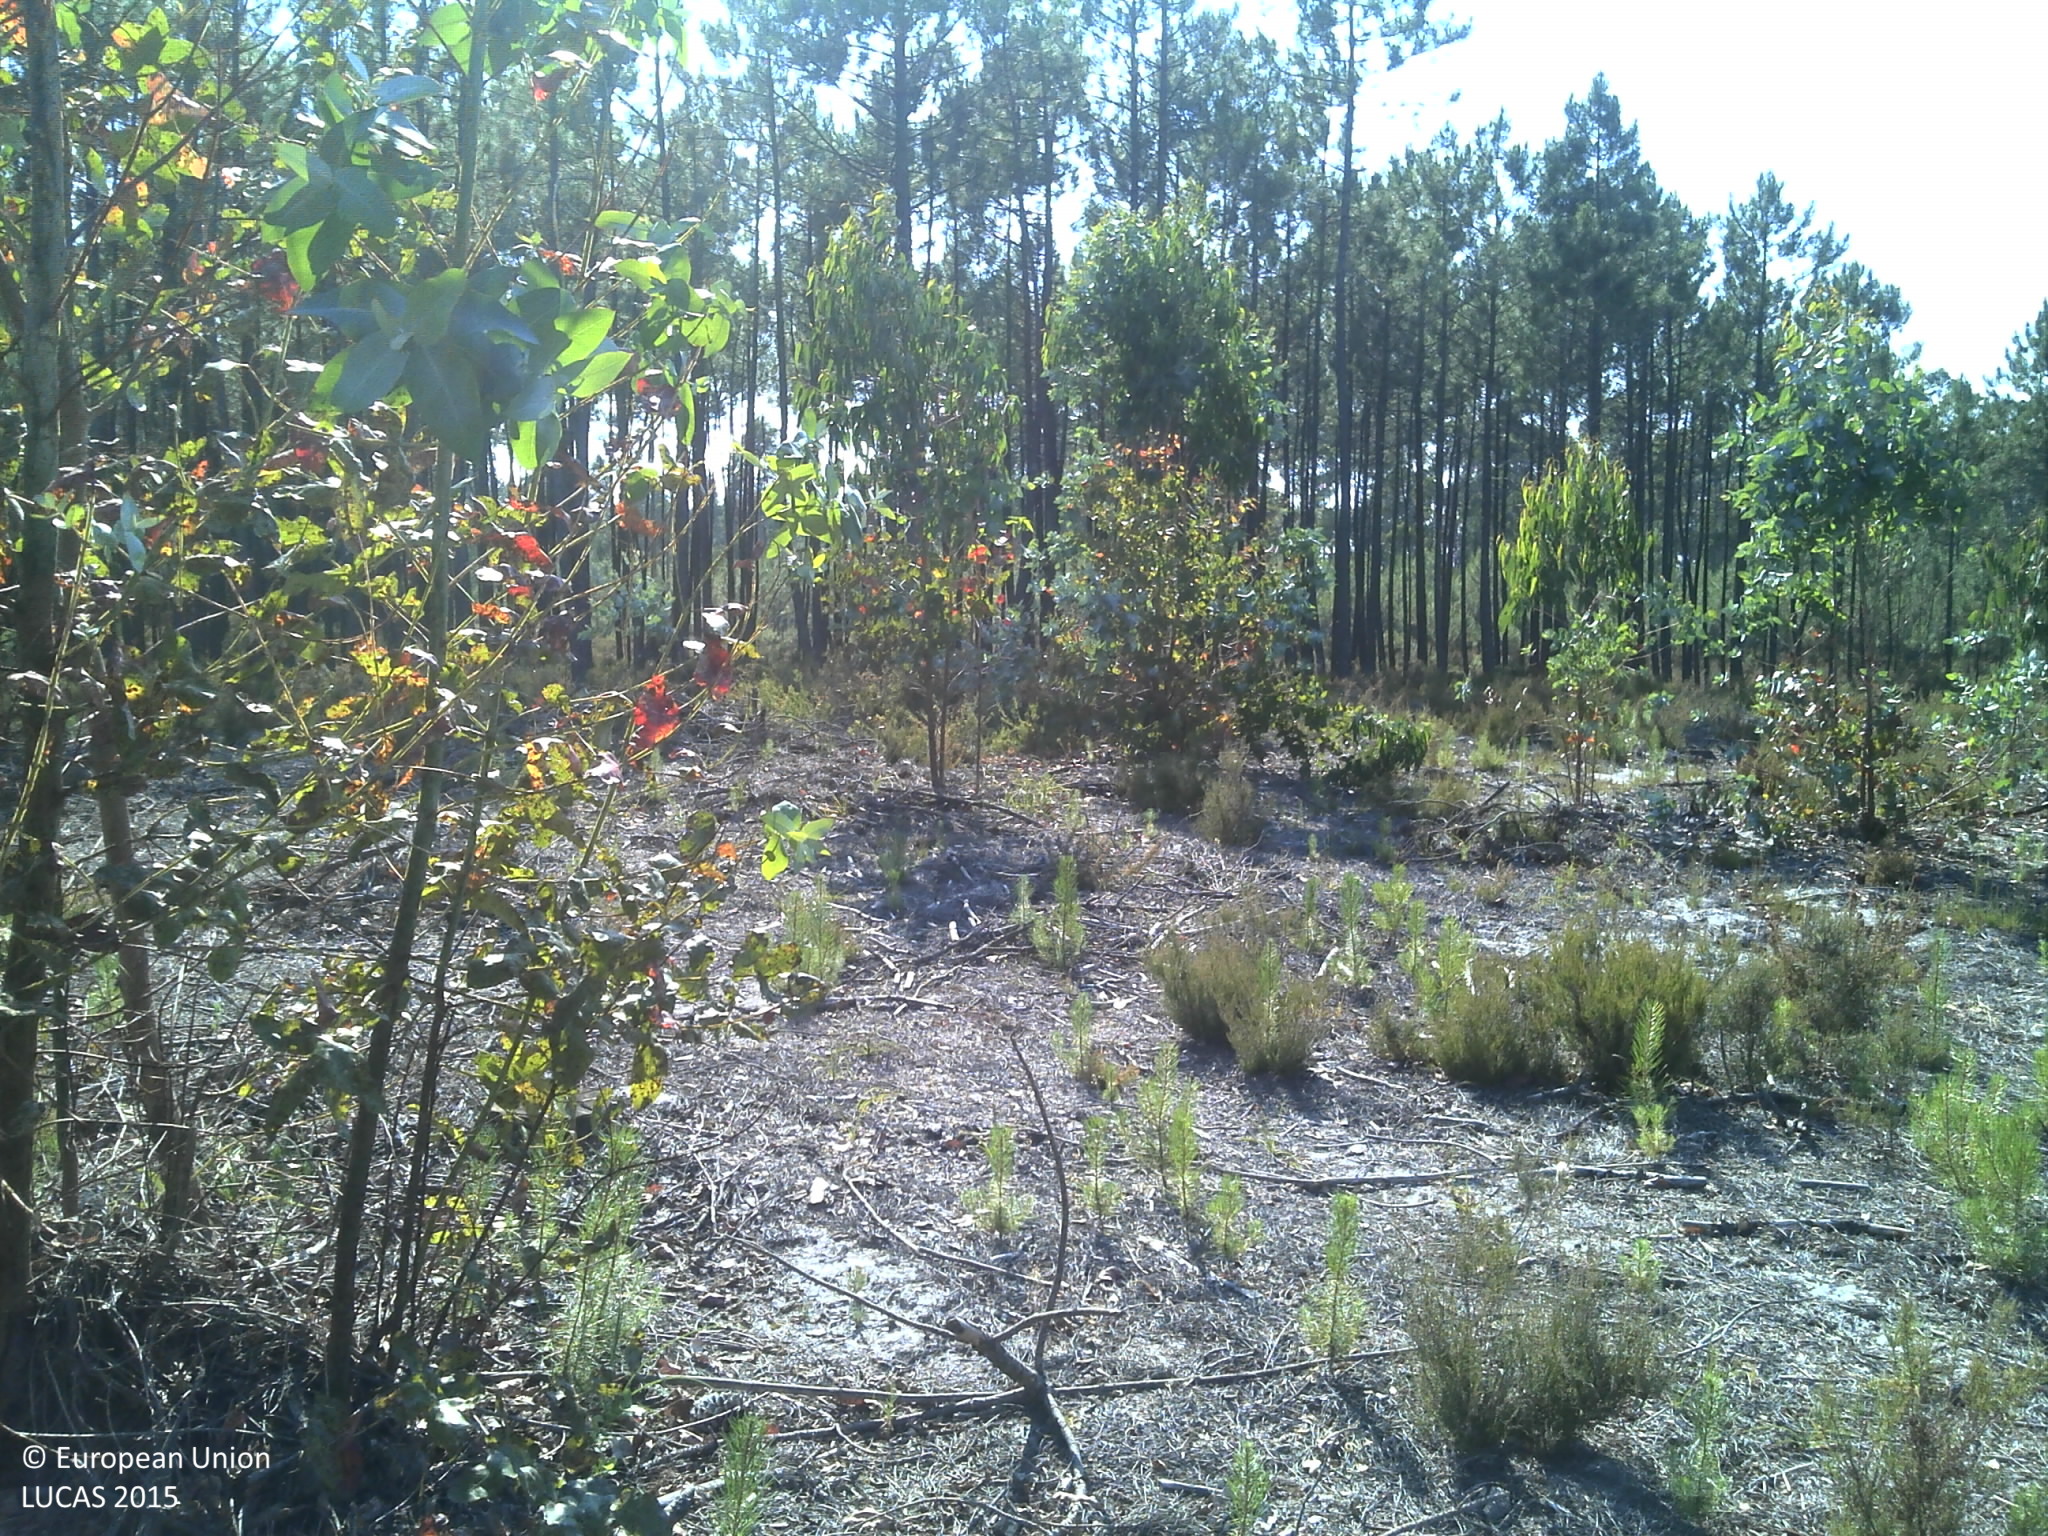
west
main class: Woodland
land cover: Broadleaved woodland
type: exotic forest
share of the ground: 10 - 25 %
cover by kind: unconsolidated bare surface 50 %, broadleaved forest trees 25 %, shrubs 25 %
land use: Forestry
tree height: < 5 m
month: June
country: PT
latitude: 40.3339
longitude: -8.6305
